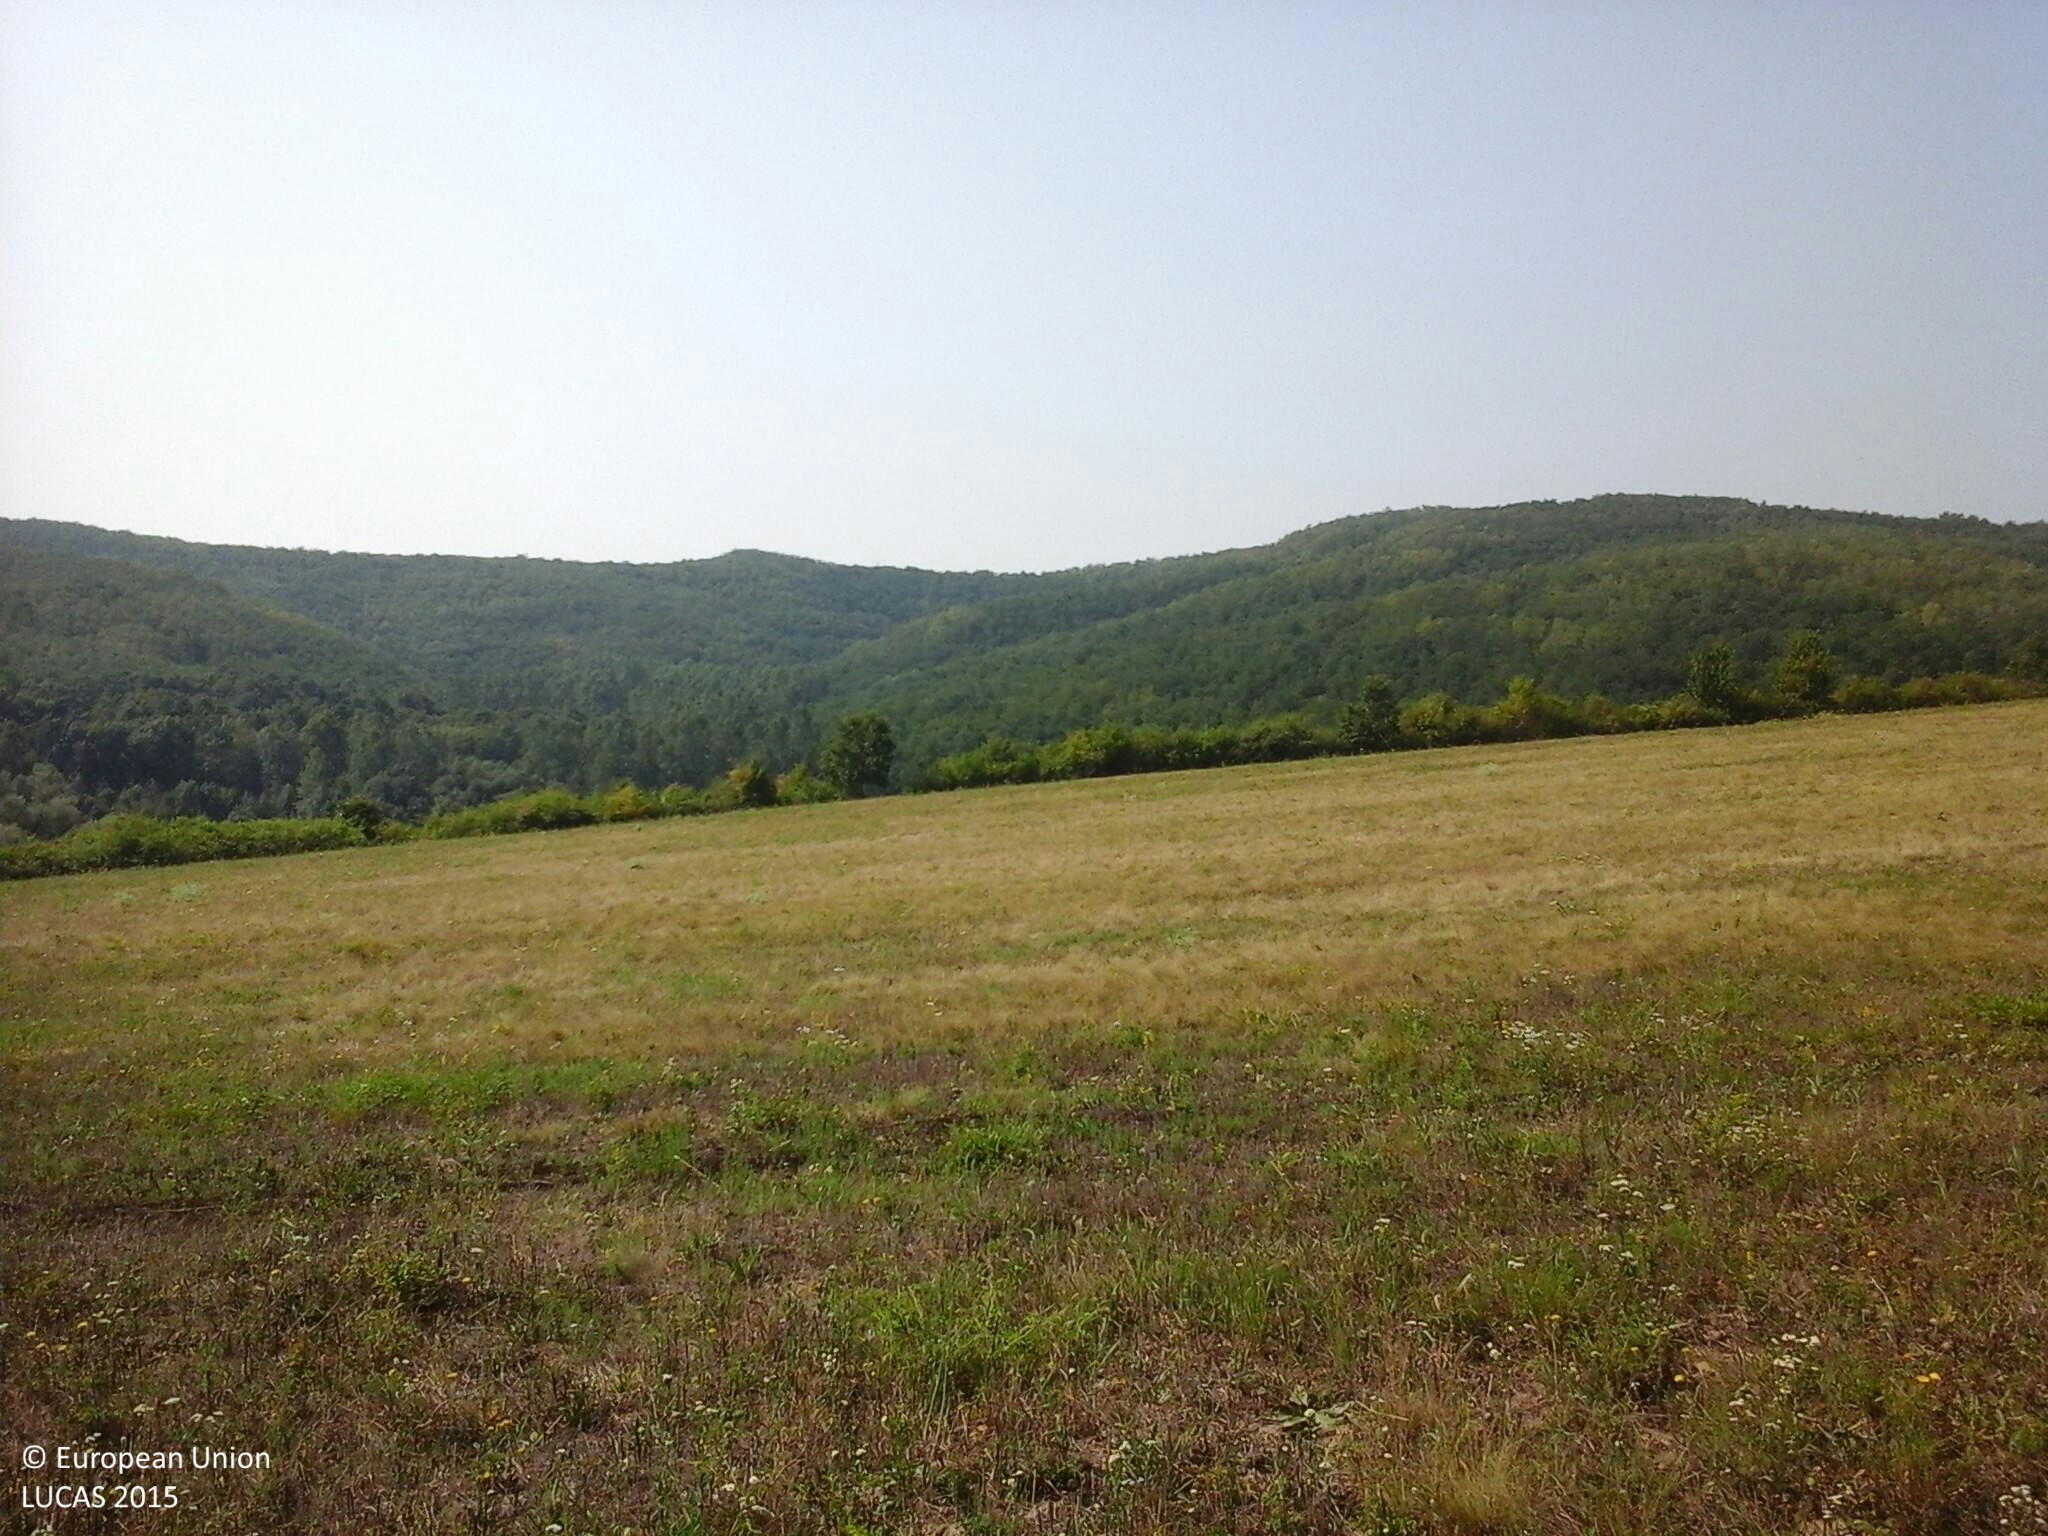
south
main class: Grassland
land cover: Grassland without tree/shrub cover
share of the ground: > 75 %
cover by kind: herbaceous plants 100 %
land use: Agriculture (excluding fallow land and kitchen gardens)
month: August
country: HU
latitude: 47.8739
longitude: 19.2057
